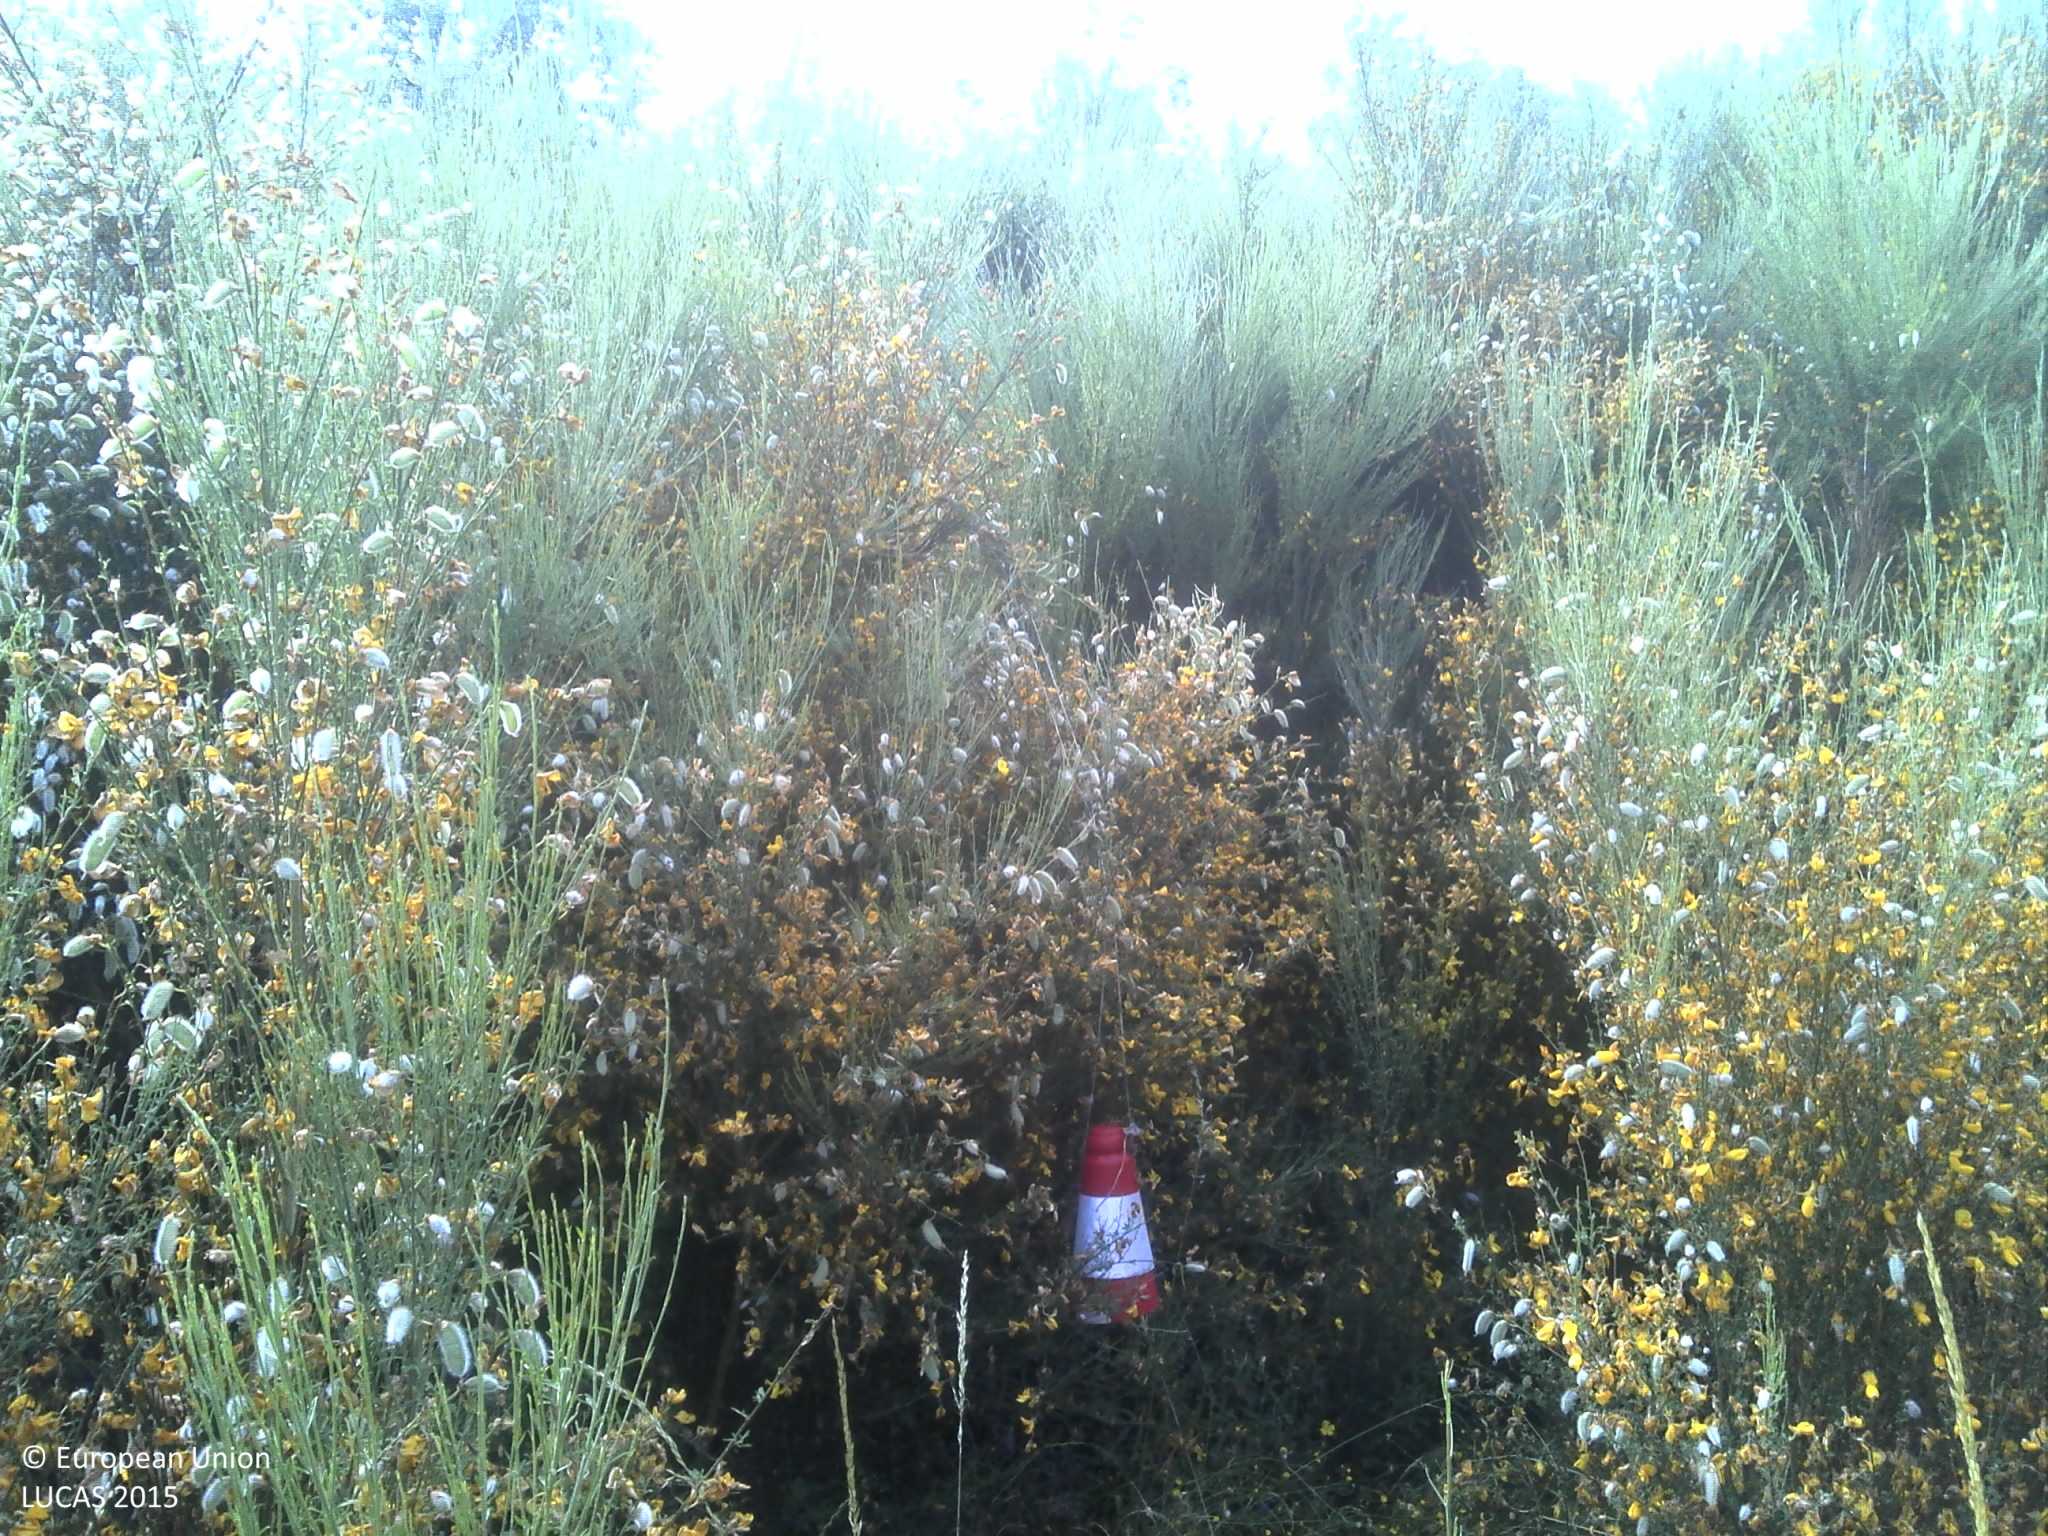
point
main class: Shrubland
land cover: Shrubland with sparse tree cover
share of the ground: 50 - 75 %
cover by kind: shrubs 75 %, unconsolidated bare surface 10 %, broadleaved forest trees 5 %, herbaceous plants 5 %
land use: Abandoned areas
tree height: < 5 m
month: June
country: PT
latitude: 40.3947
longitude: -7.1000
